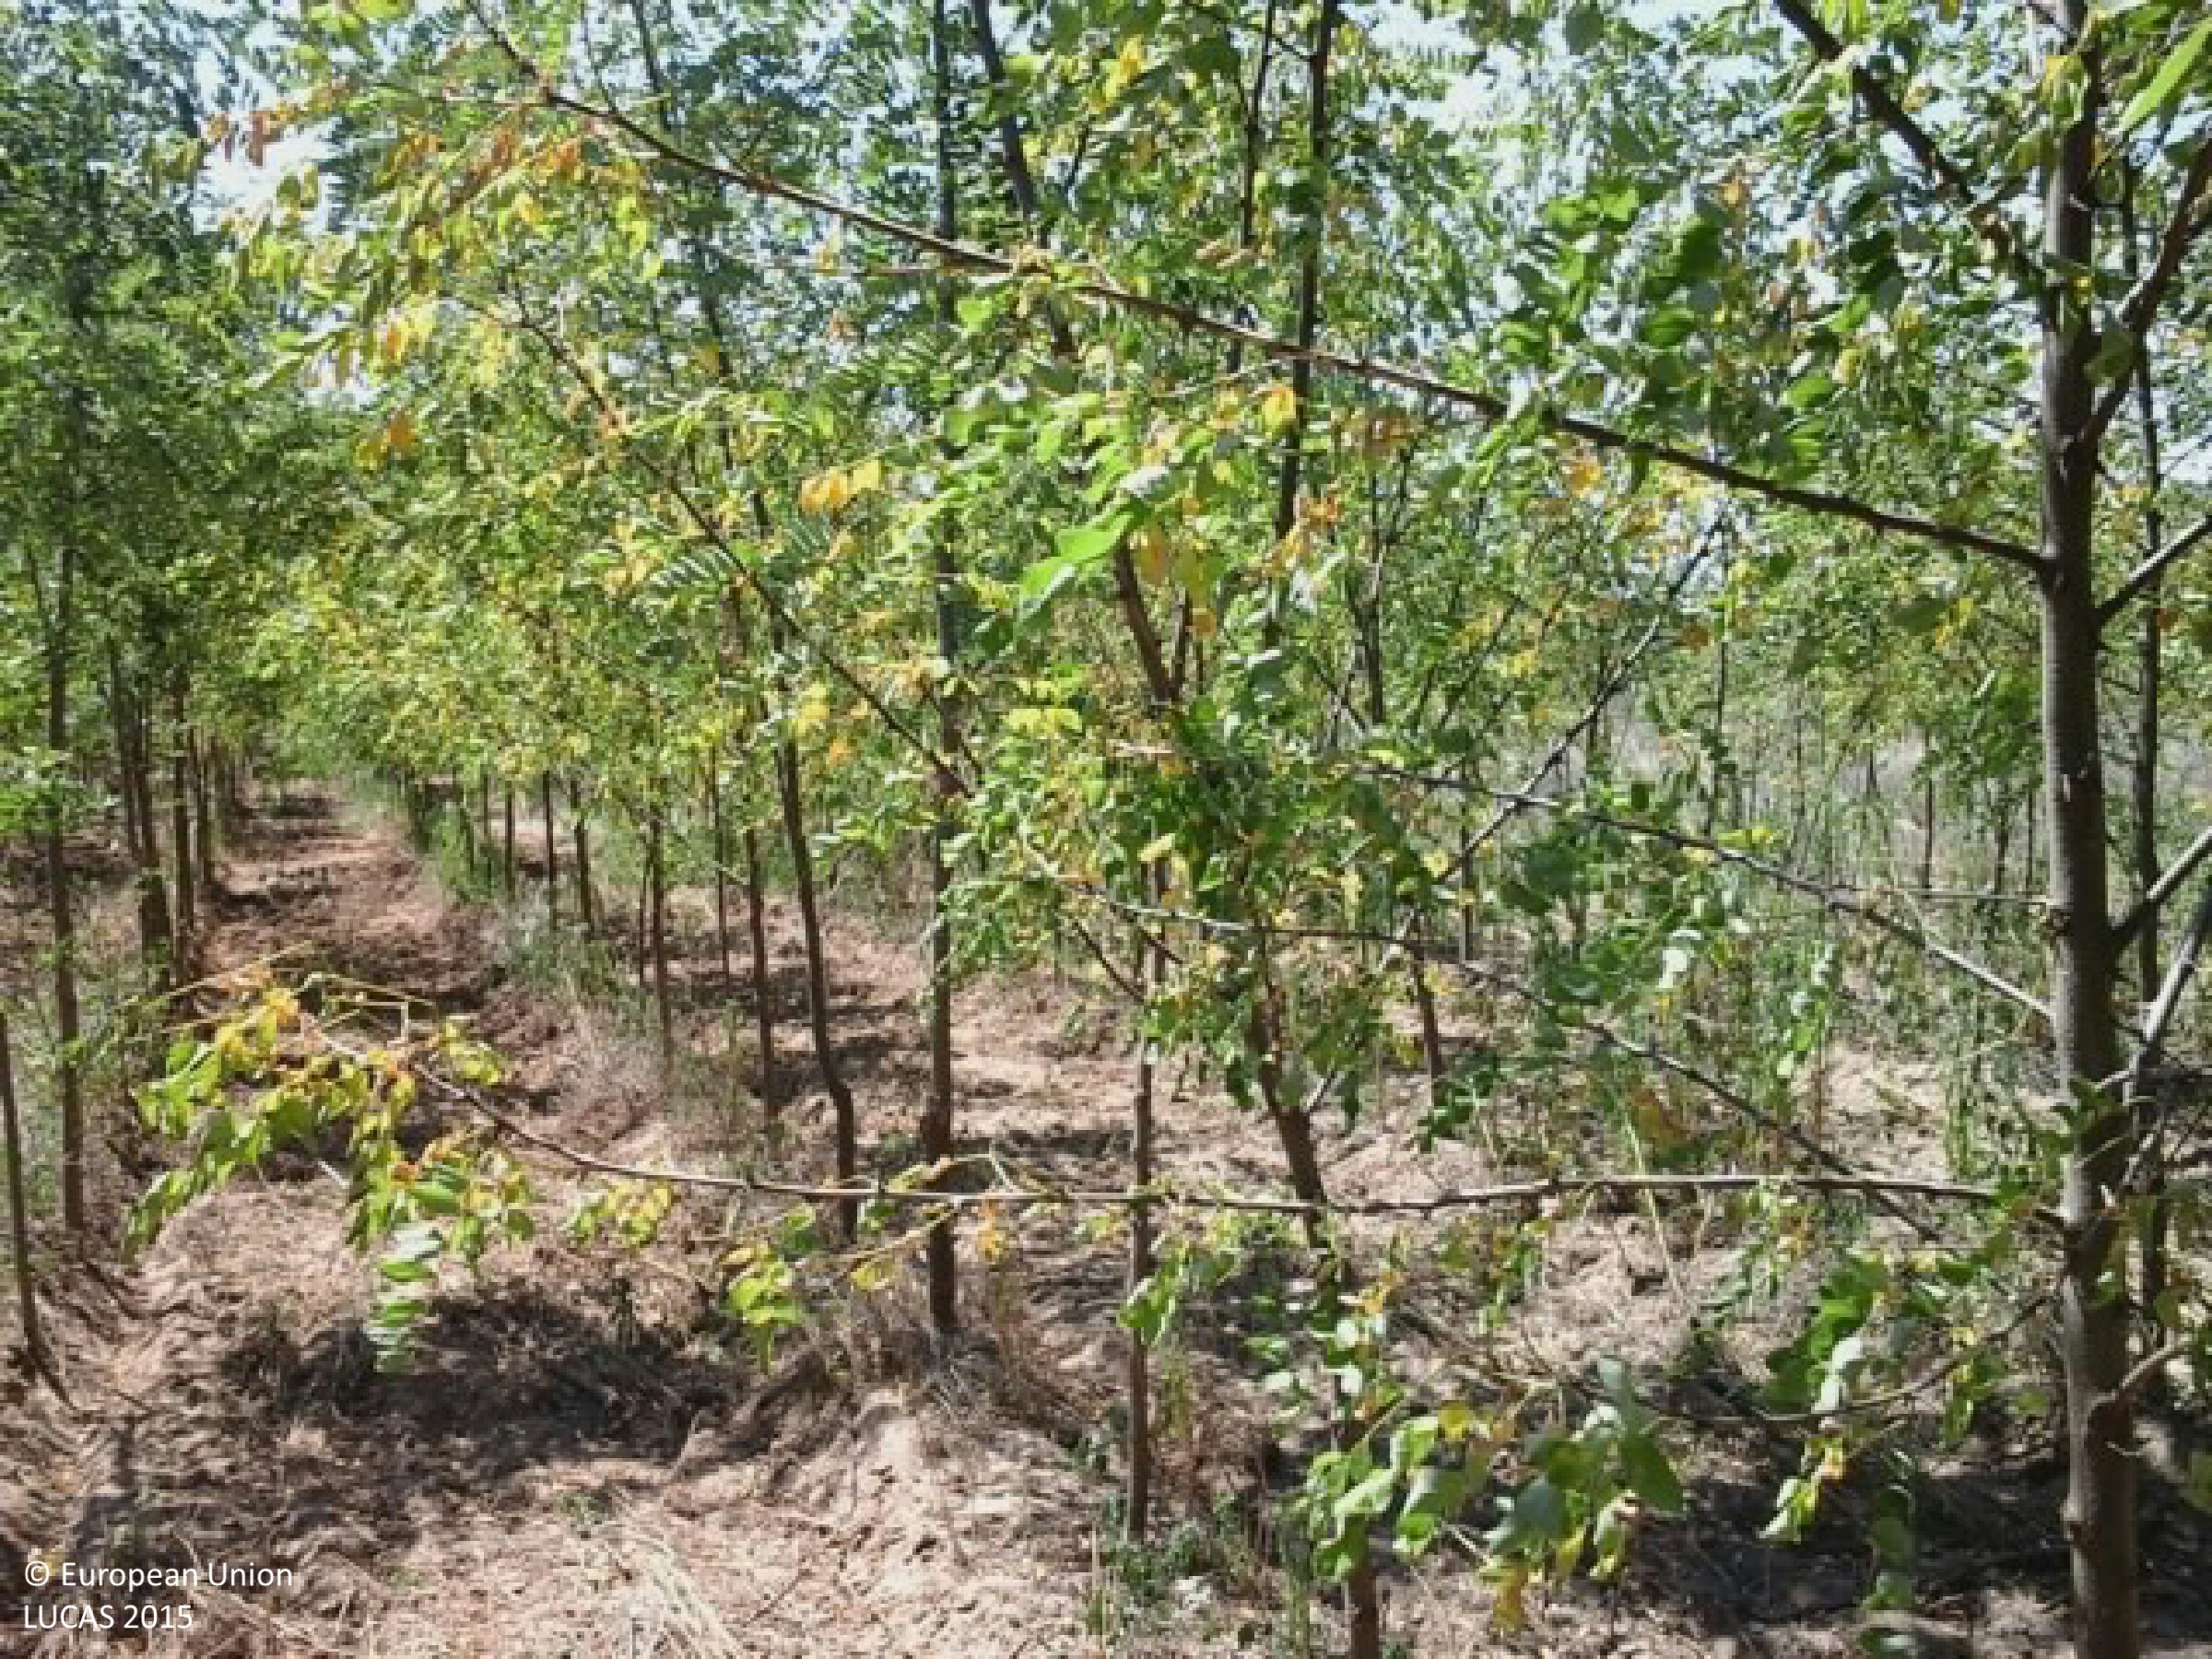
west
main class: Woodland
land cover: Broadleaved woodland
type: exotic forest
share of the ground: 50 - 75 %
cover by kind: broadleaved forest trees 70 %, herbaceous plants 15 %, unconsolidated bare surface 15 %
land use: Forestry
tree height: < 5 m
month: July
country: HU
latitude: 47.2896
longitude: 19.2613
